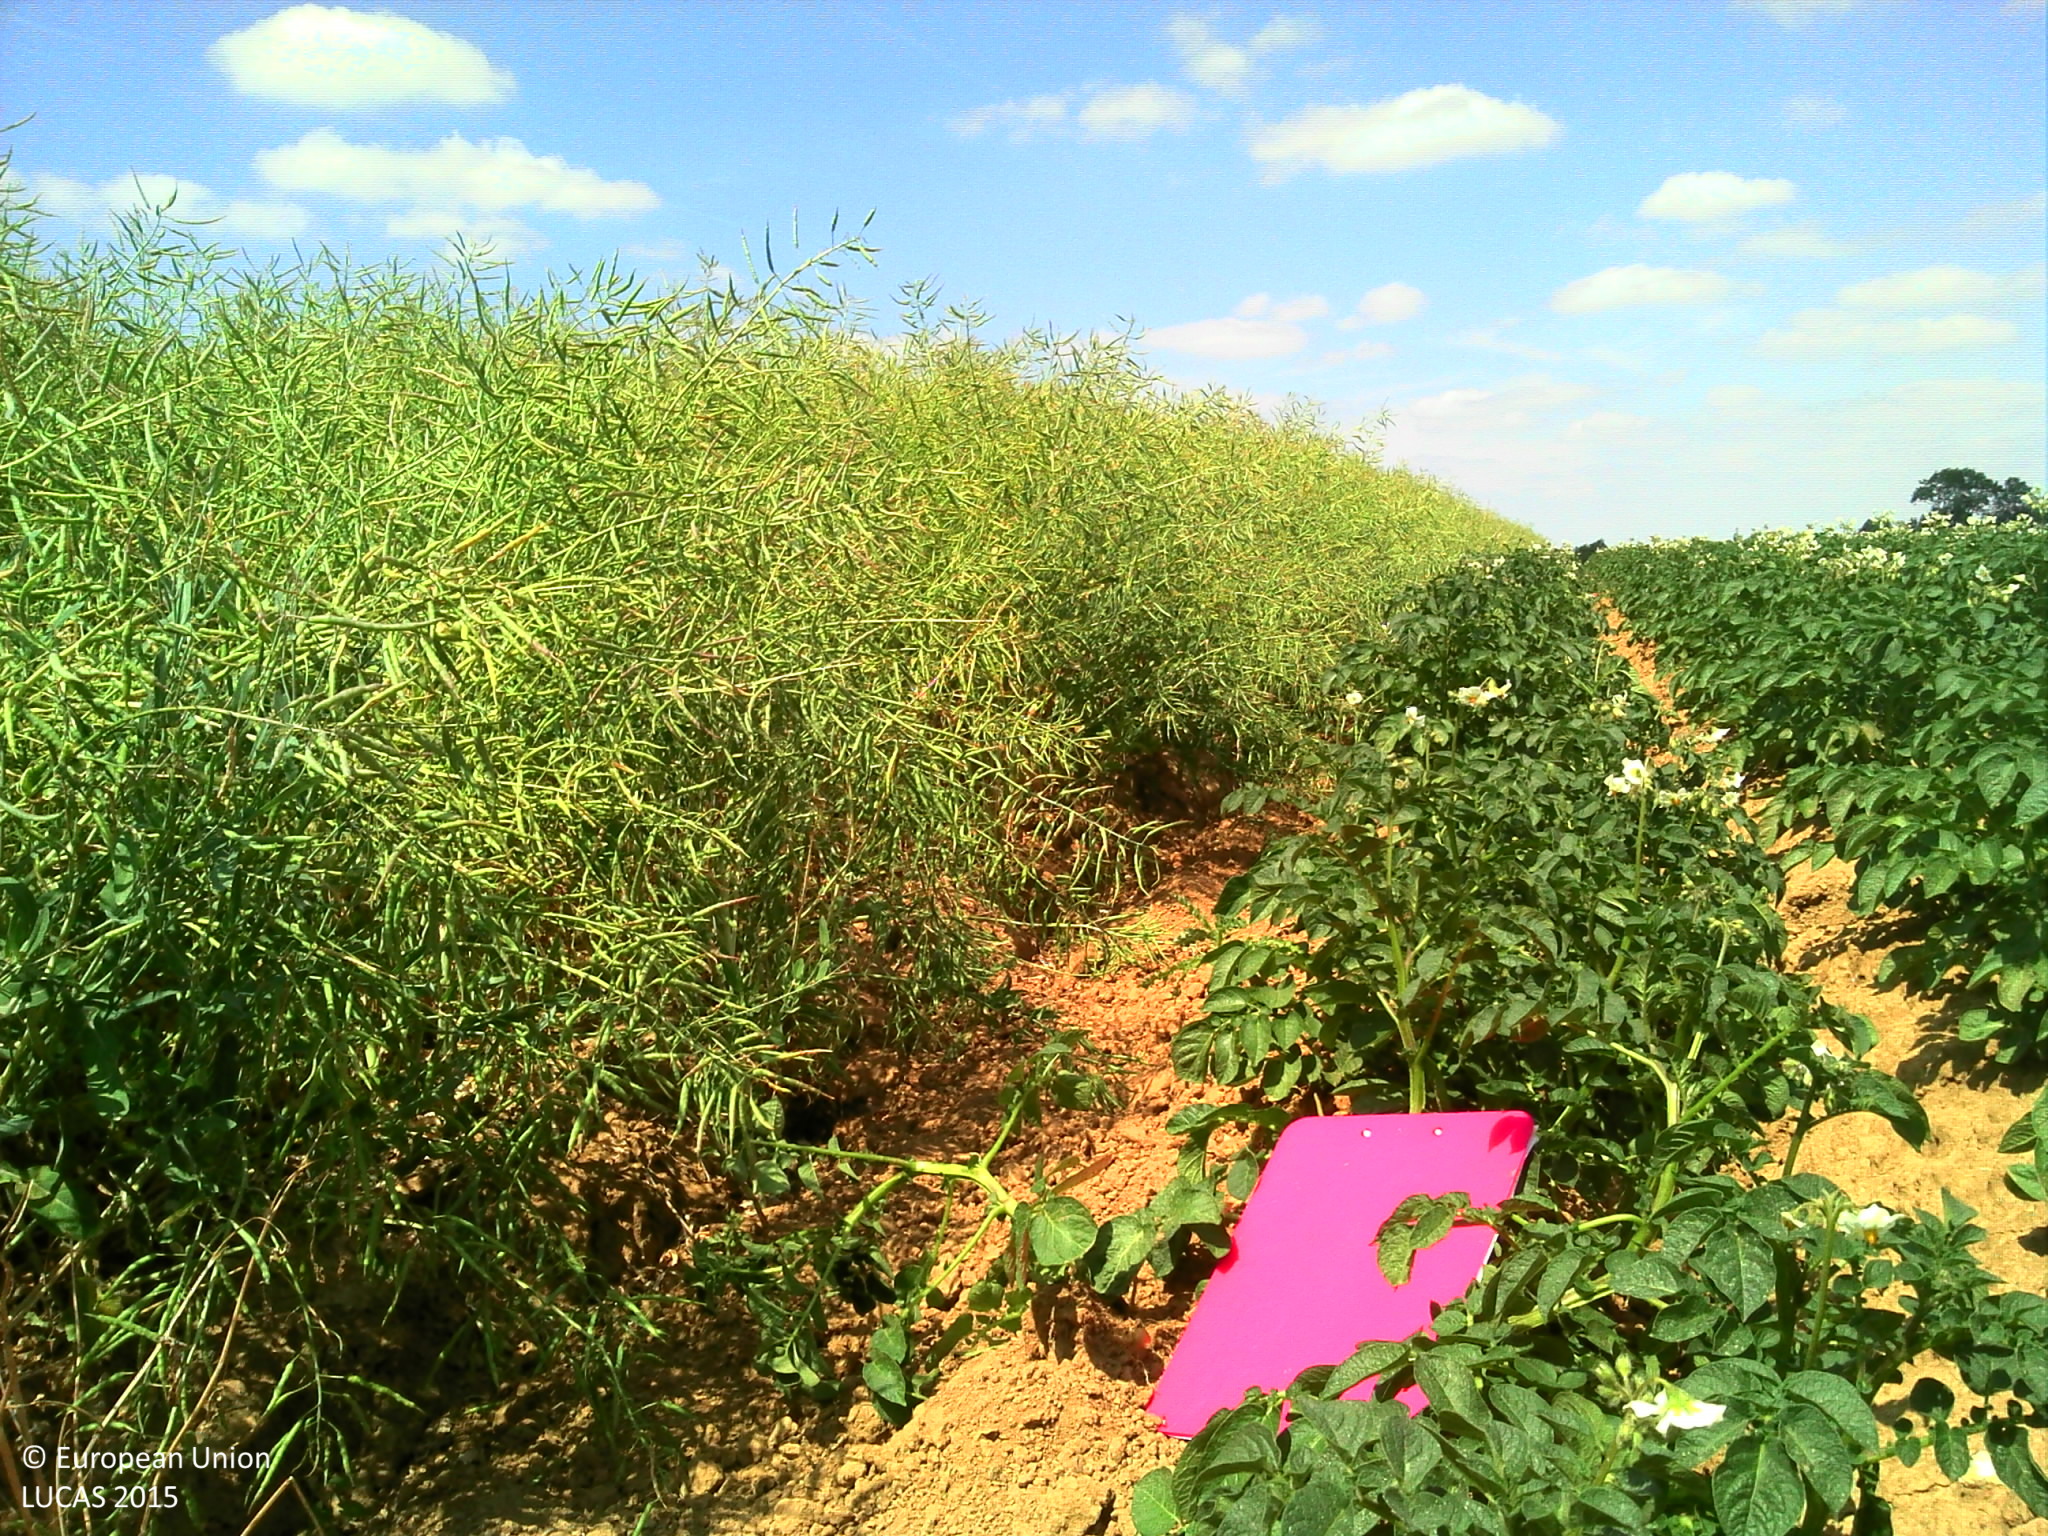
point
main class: Cropland
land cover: Rape and turnip rape
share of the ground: > 75 %
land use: Agriculture (excluding fallow land and kitchen gardens)
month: June
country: FR
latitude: 49.6531
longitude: 2.8563
